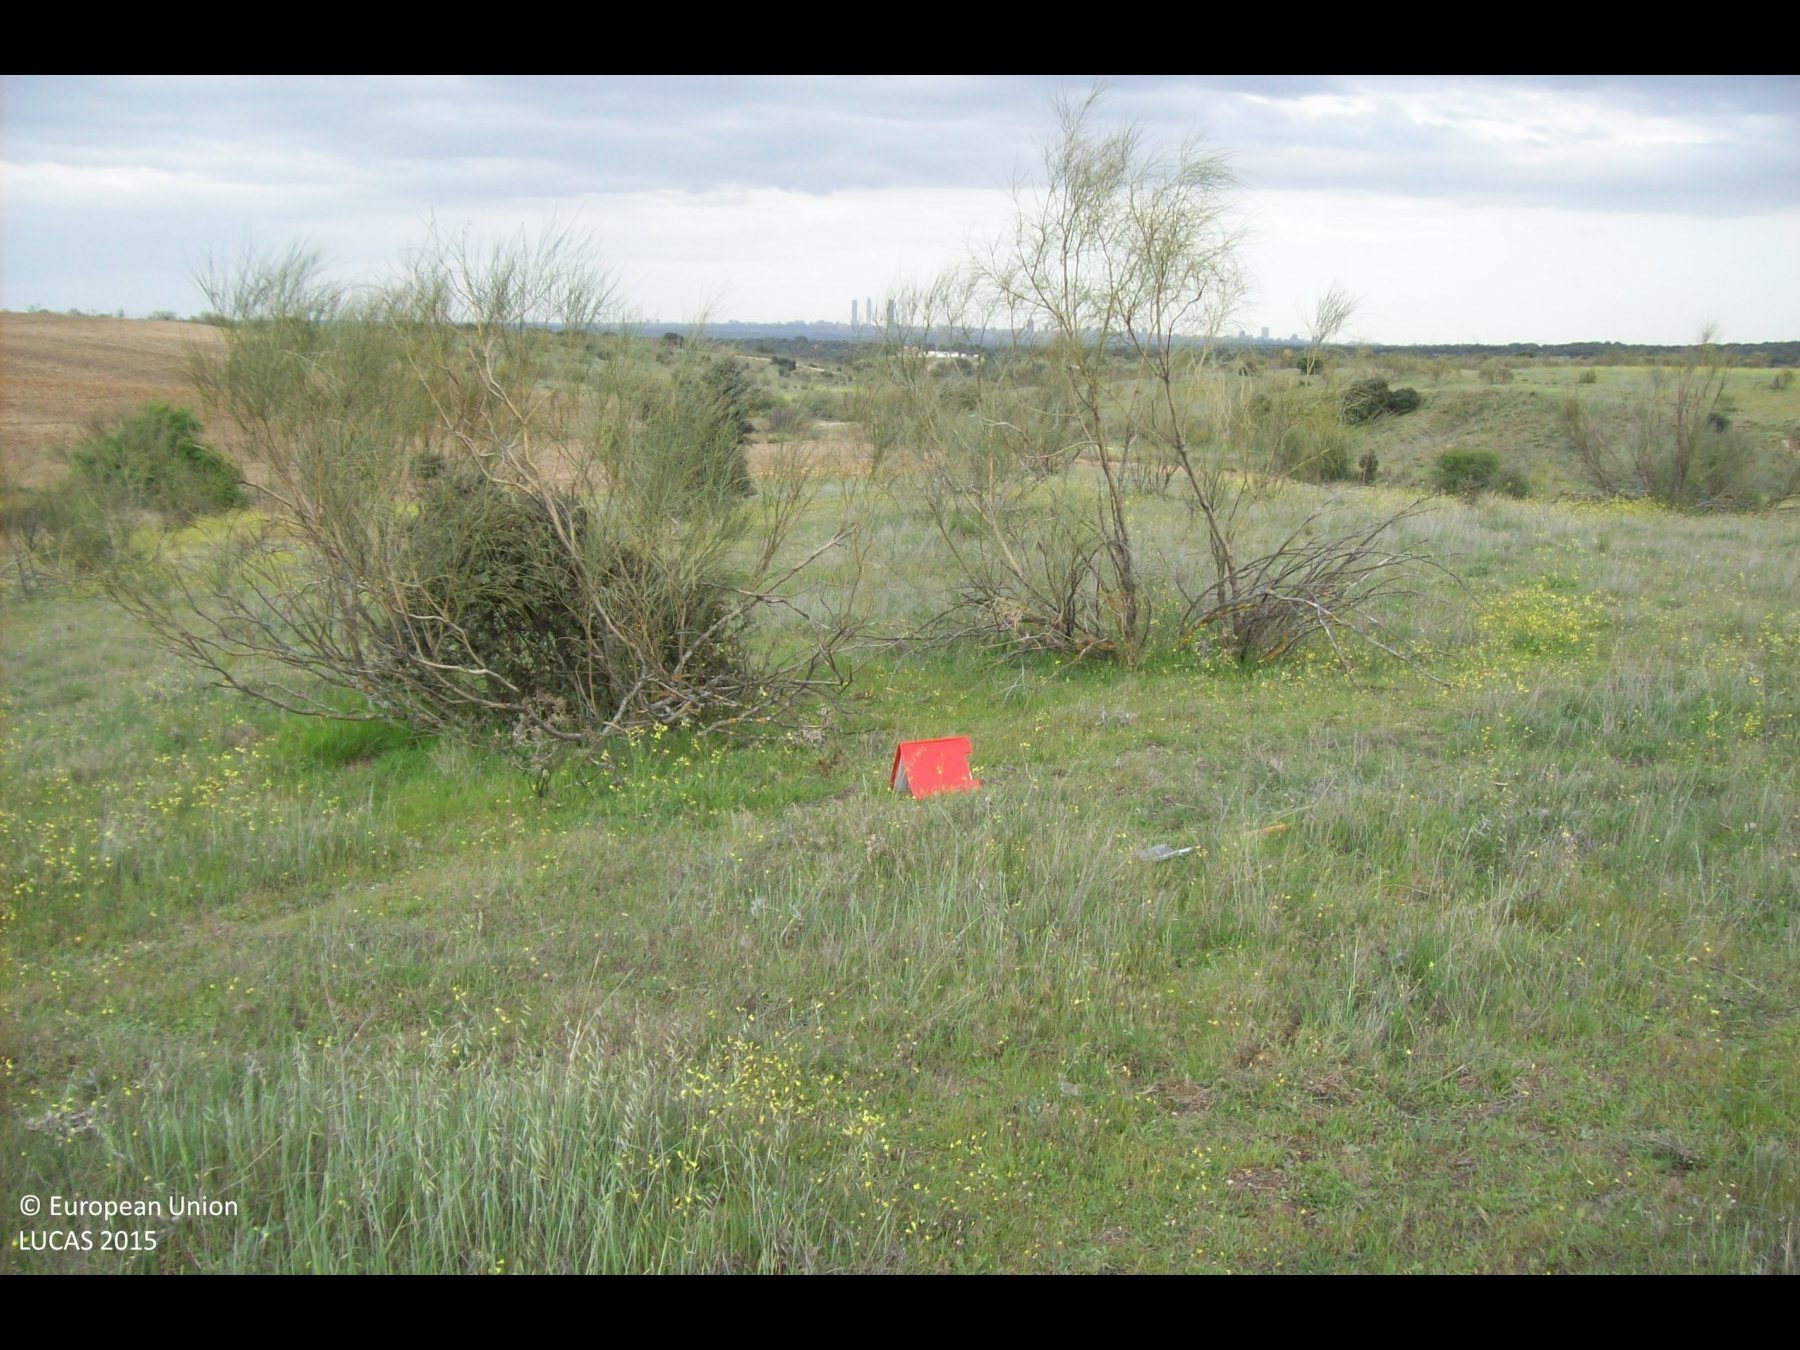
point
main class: Grassland
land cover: Grassland with sparse tree/shrub cover
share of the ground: > 75 %
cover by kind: herbaceous plants 90 %, broadleaved forest trees 5 %, shrubs 5 %
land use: Semi-natural and natural areas not in use
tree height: < 5 m
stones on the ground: < 10 %
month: April
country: ES
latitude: 40.5060
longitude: -3.8596
